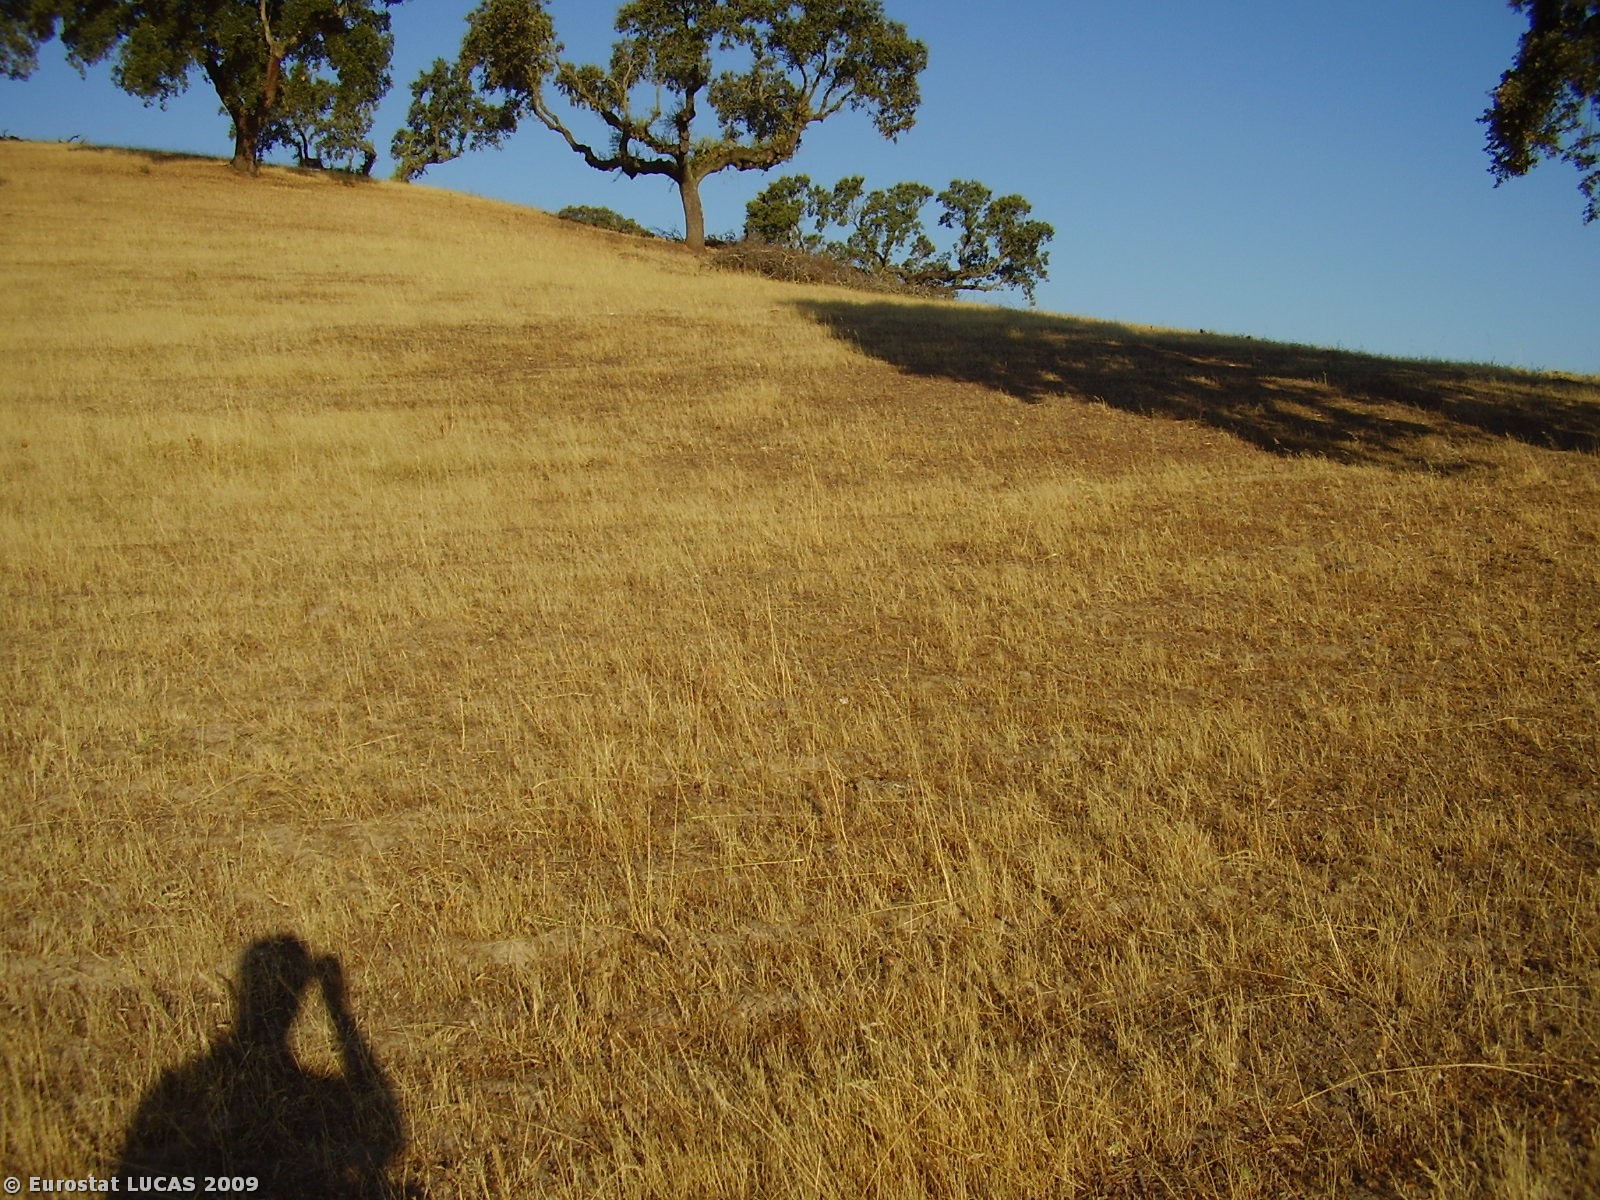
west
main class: Grassland
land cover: Grassland with sparse tree/shrub cover
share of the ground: > 75 %
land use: Agriculture (excluding fallow land and kitchen gardens)
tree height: > 5 m
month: July
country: PT
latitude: 38.6443
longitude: -7.2951
